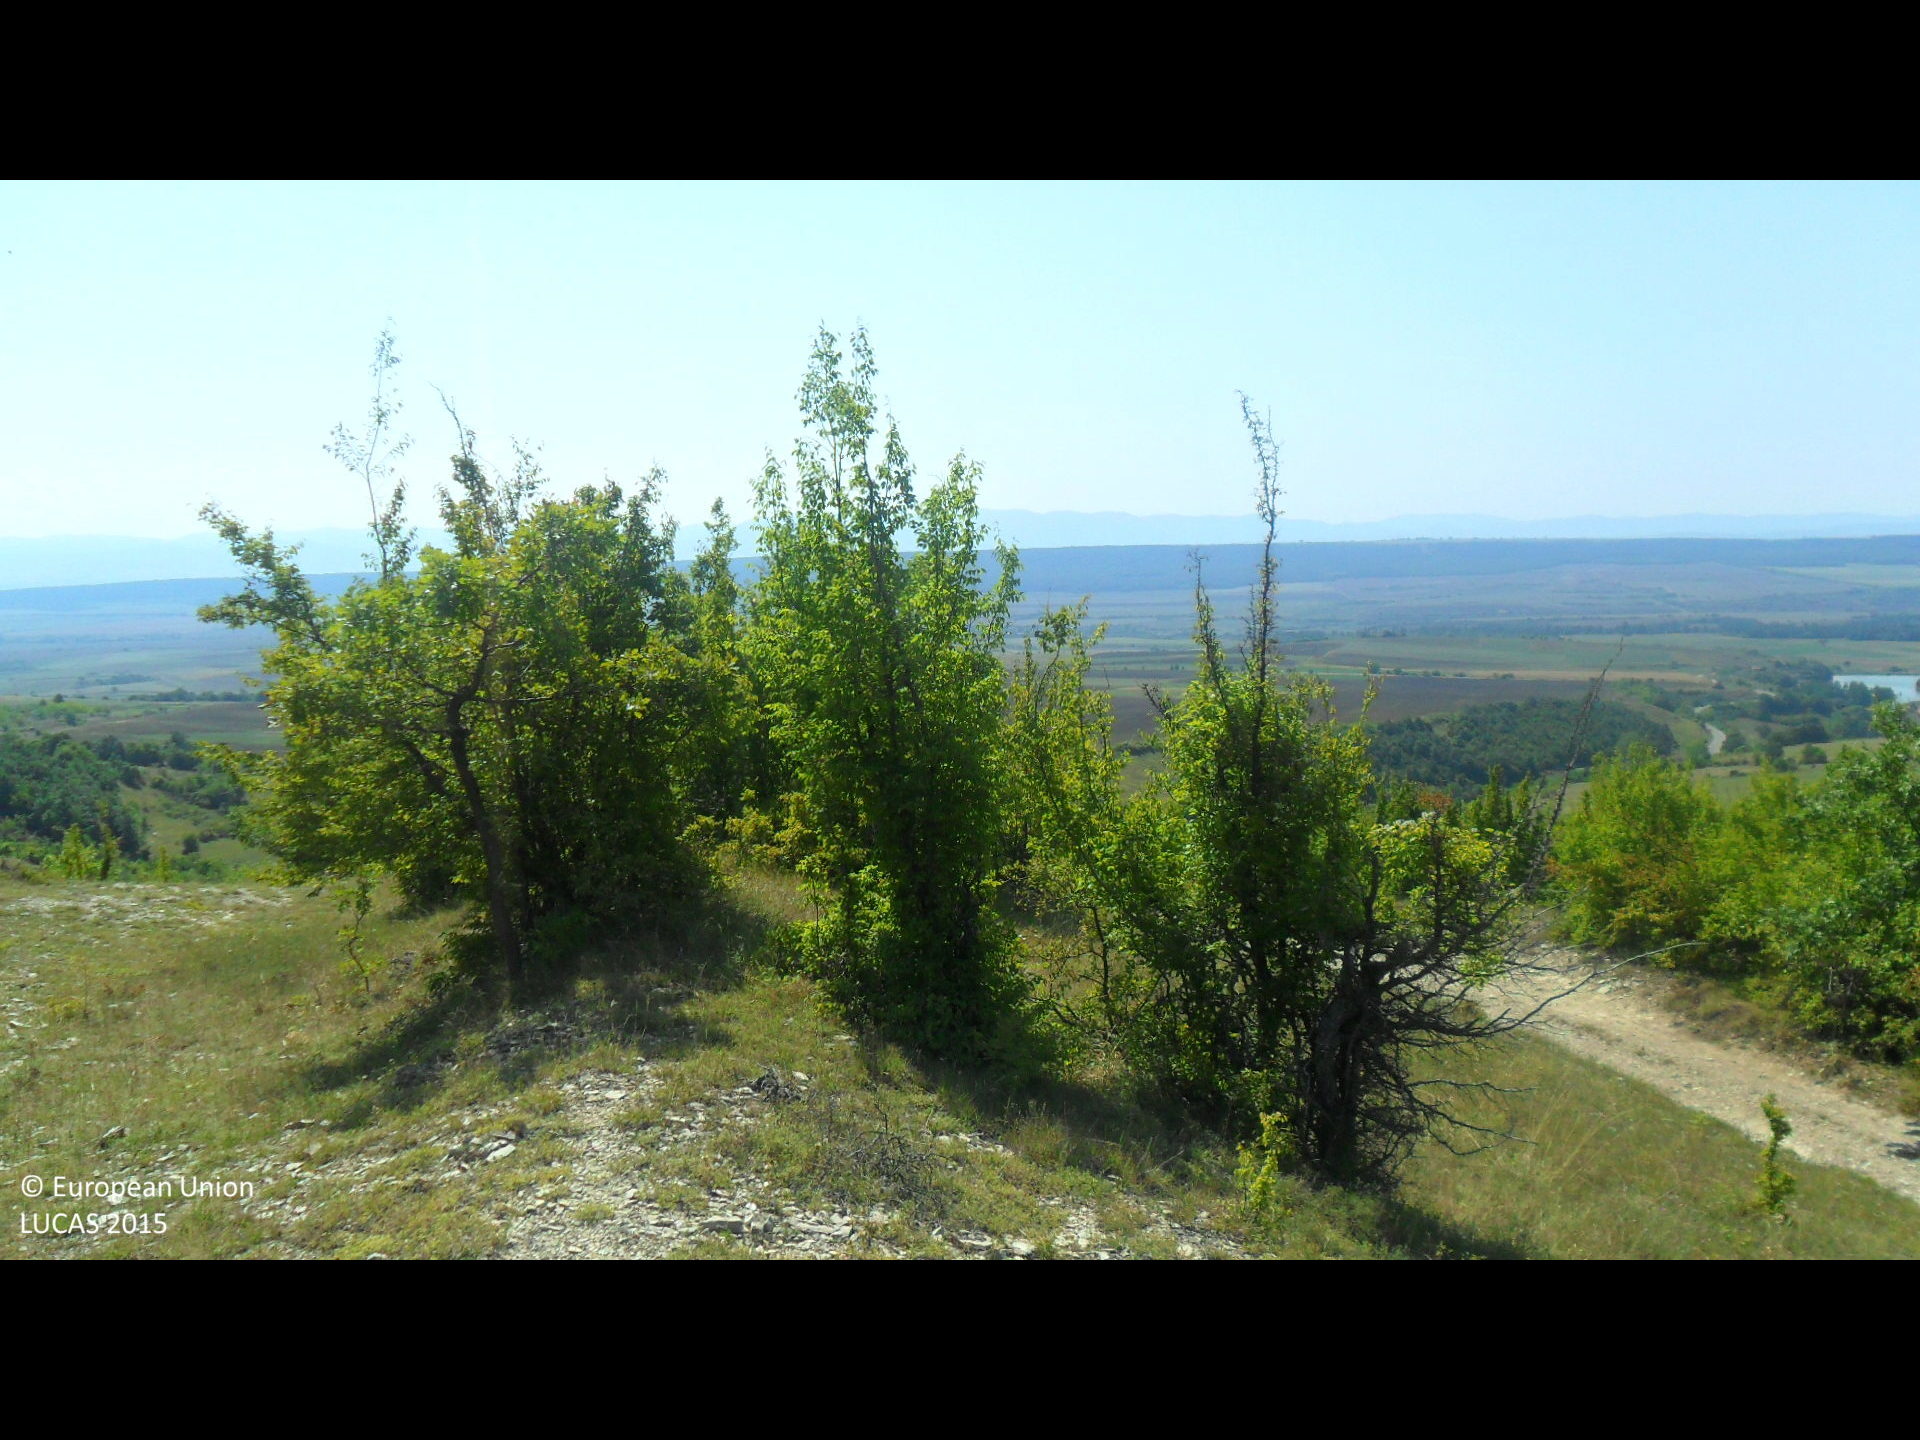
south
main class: Woodland
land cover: Broadleaved woodland
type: thermophilous deciduous forest
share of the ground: > 75 %
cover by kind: broadleaved forest trees 95 %, unconsolidated bare surface 5 %
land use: Forestry
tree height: > 5 m
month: September
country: BG
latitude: 43.1465
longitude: 26.6168
